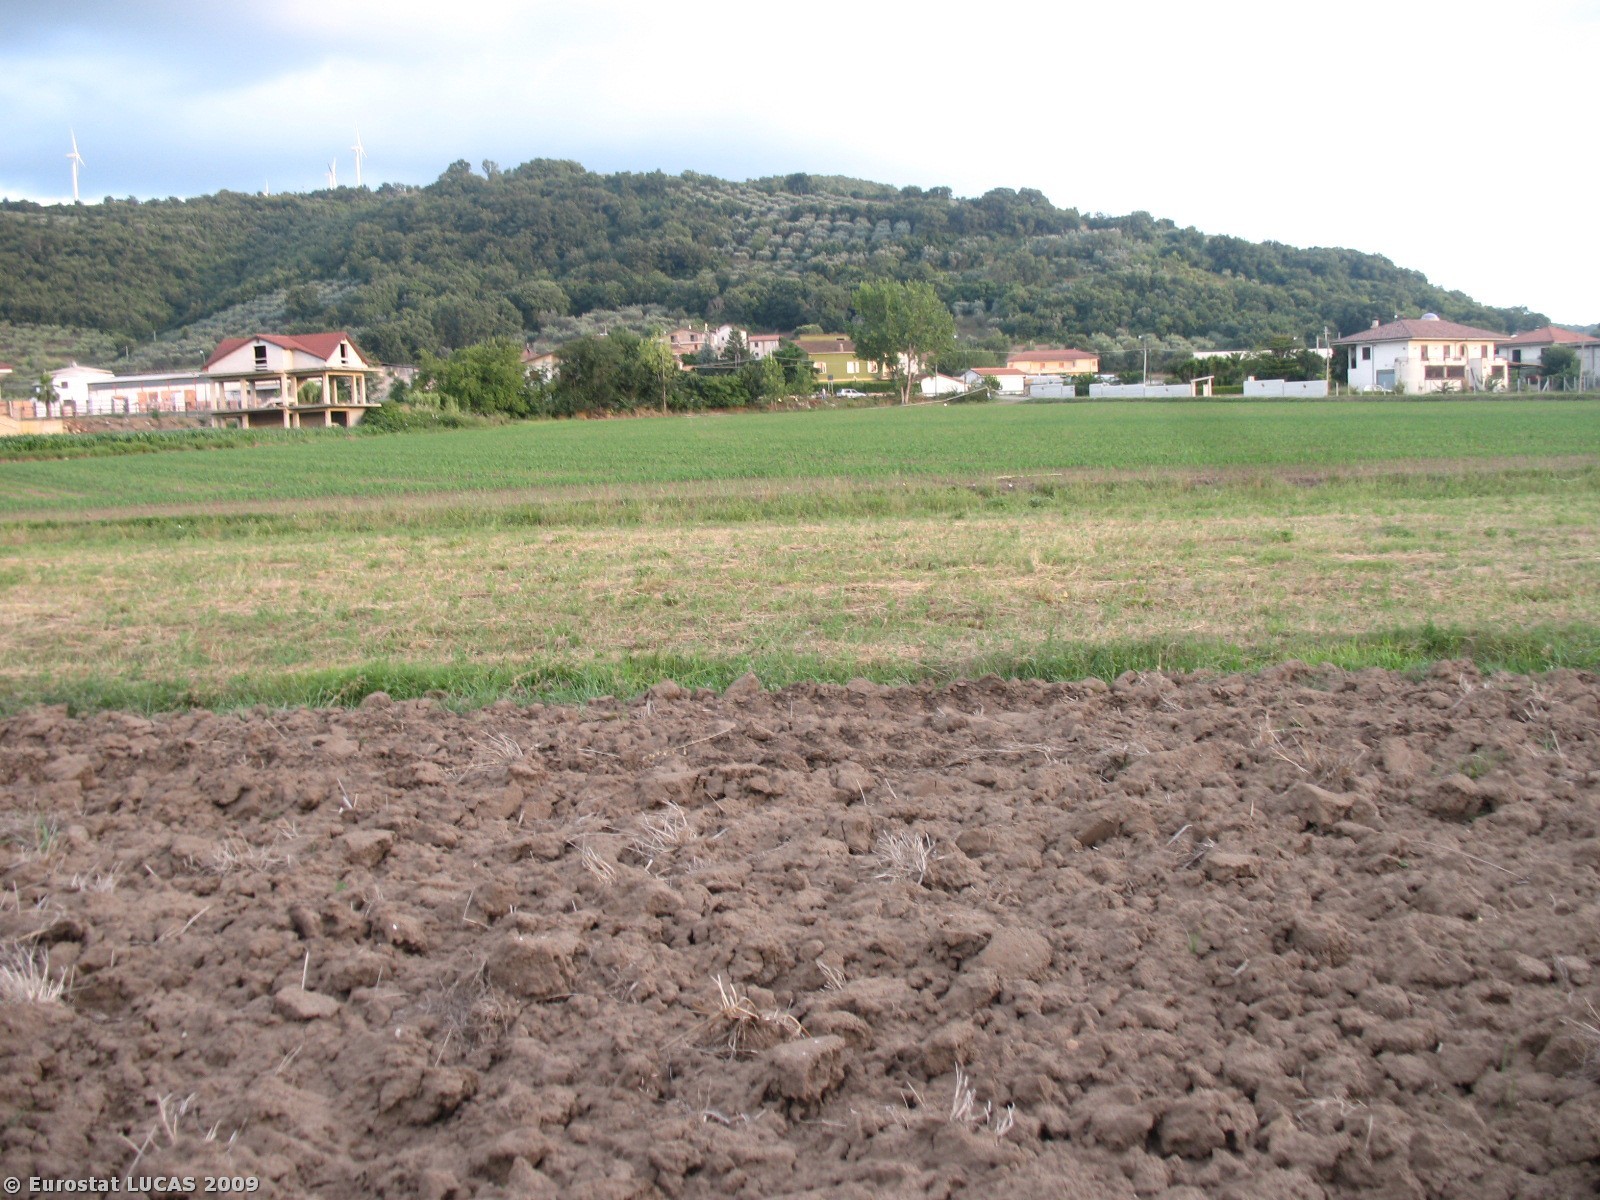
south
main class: Cropland
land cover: Temporary grasslands
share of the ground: < 10 %
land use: Agriculture (excluding fallow land and kitchen gardens)
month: July
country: IT
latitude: 40.4991
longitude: 15.0642
